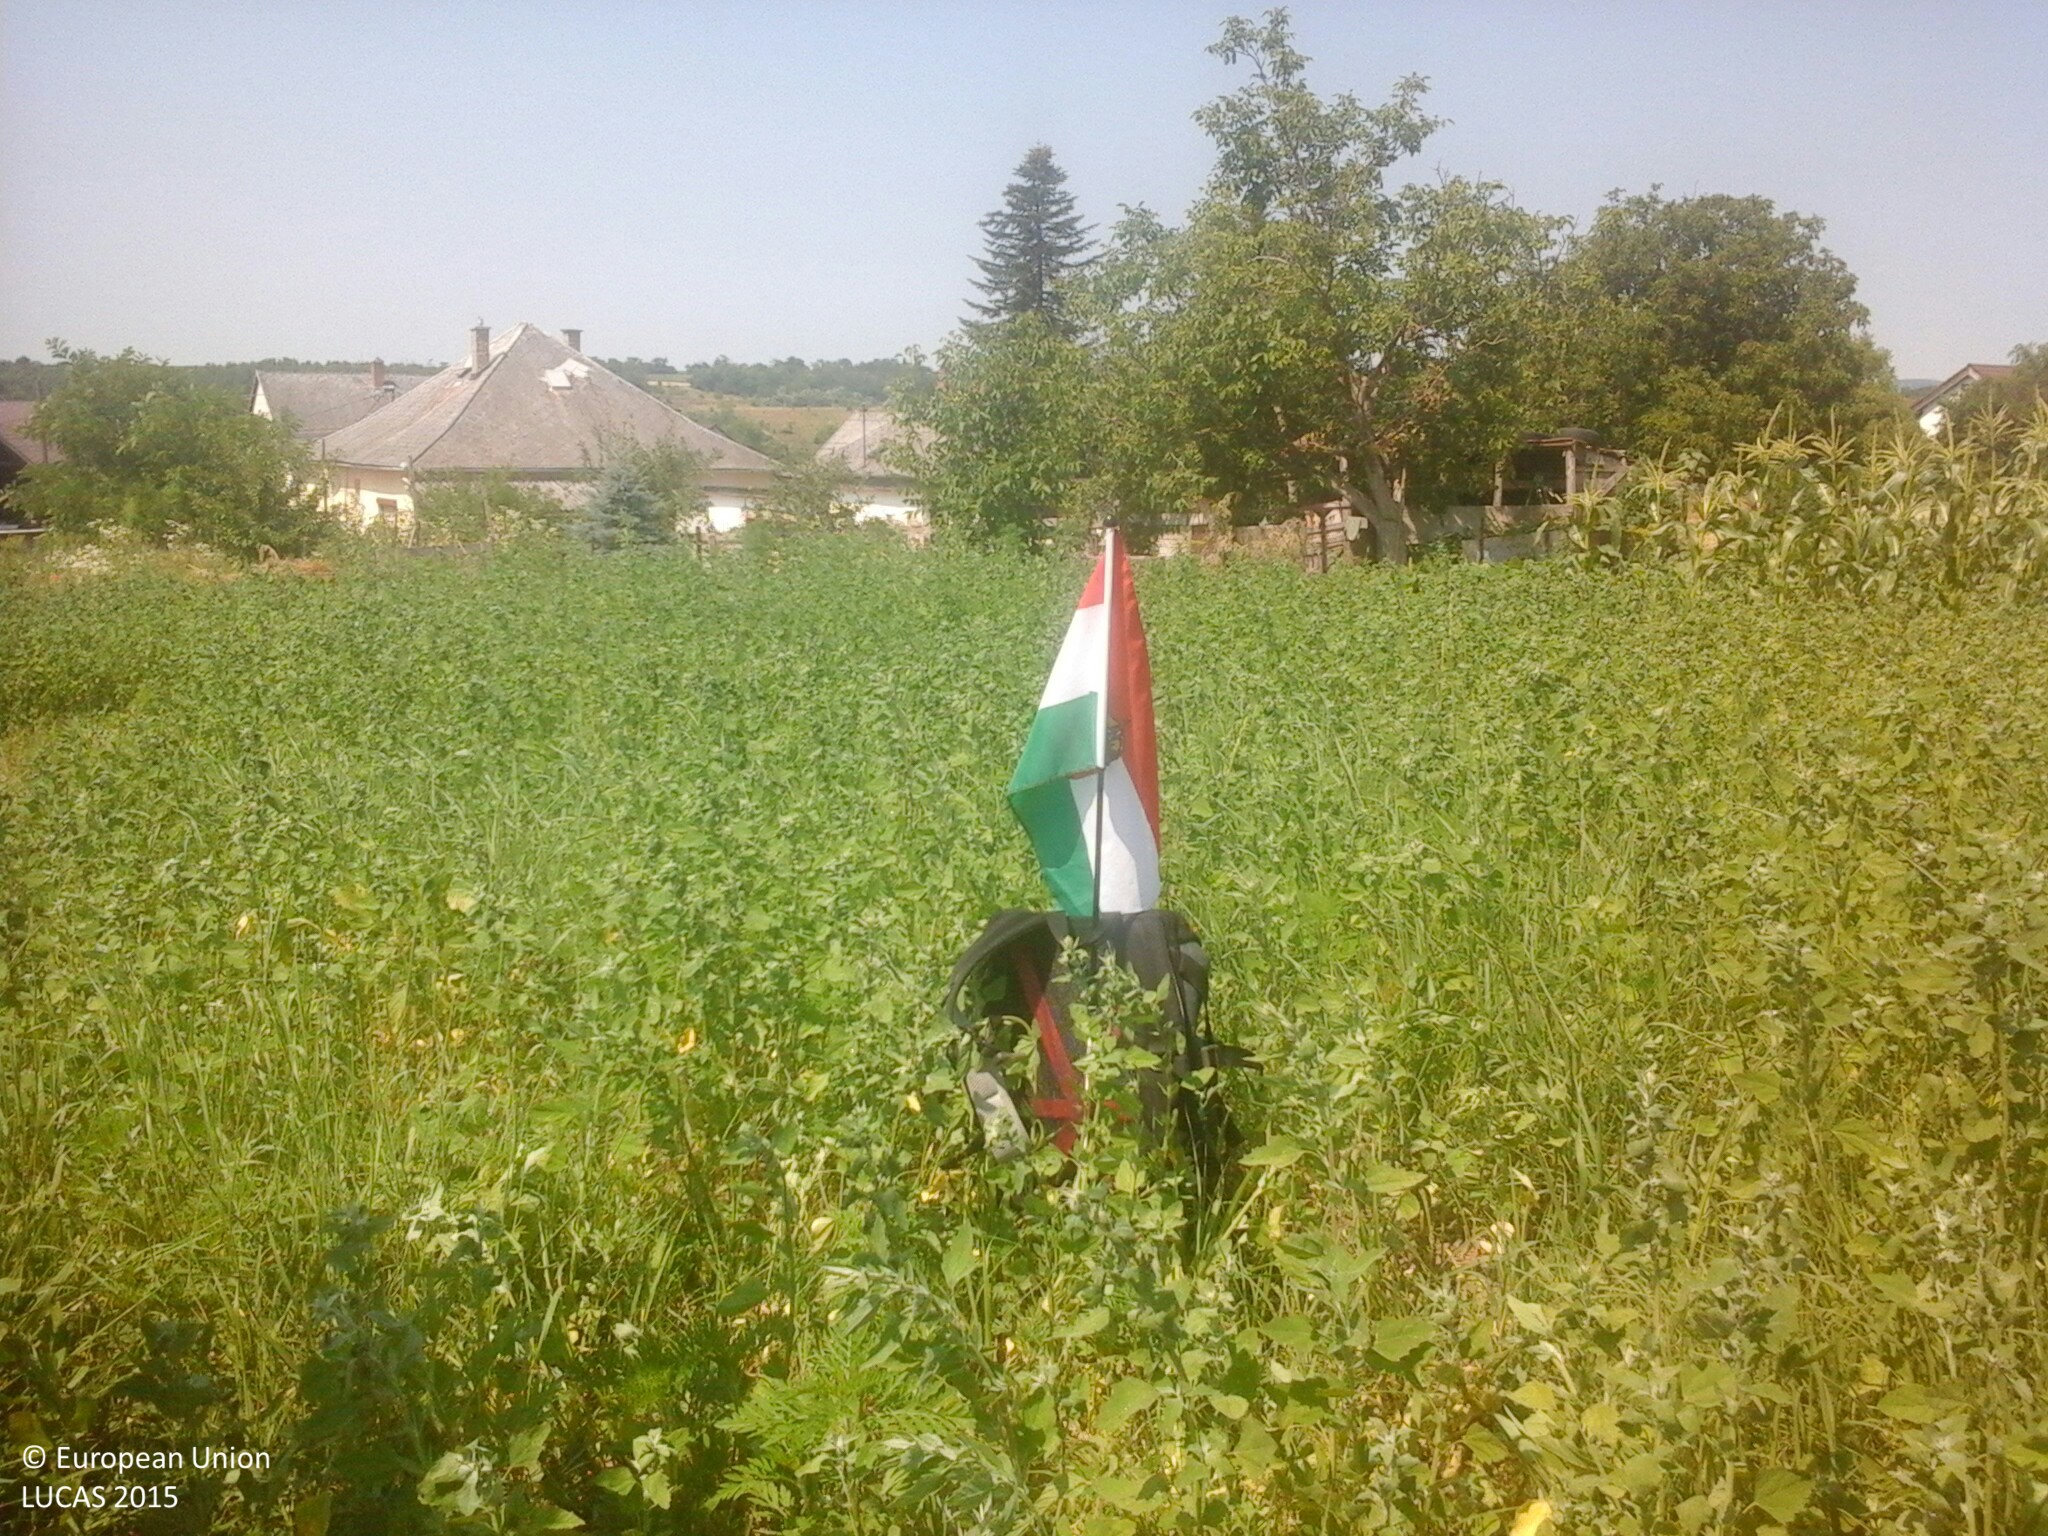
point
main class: Grassland
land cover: Spontaneously vegetated surfaces
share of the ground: > 75 %
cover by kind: herbaceous plants 100 %
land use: Agriculture (excluding fallow land and kitchen gardens)
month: July
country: HU
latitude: 47.4351
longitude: 18.5928
